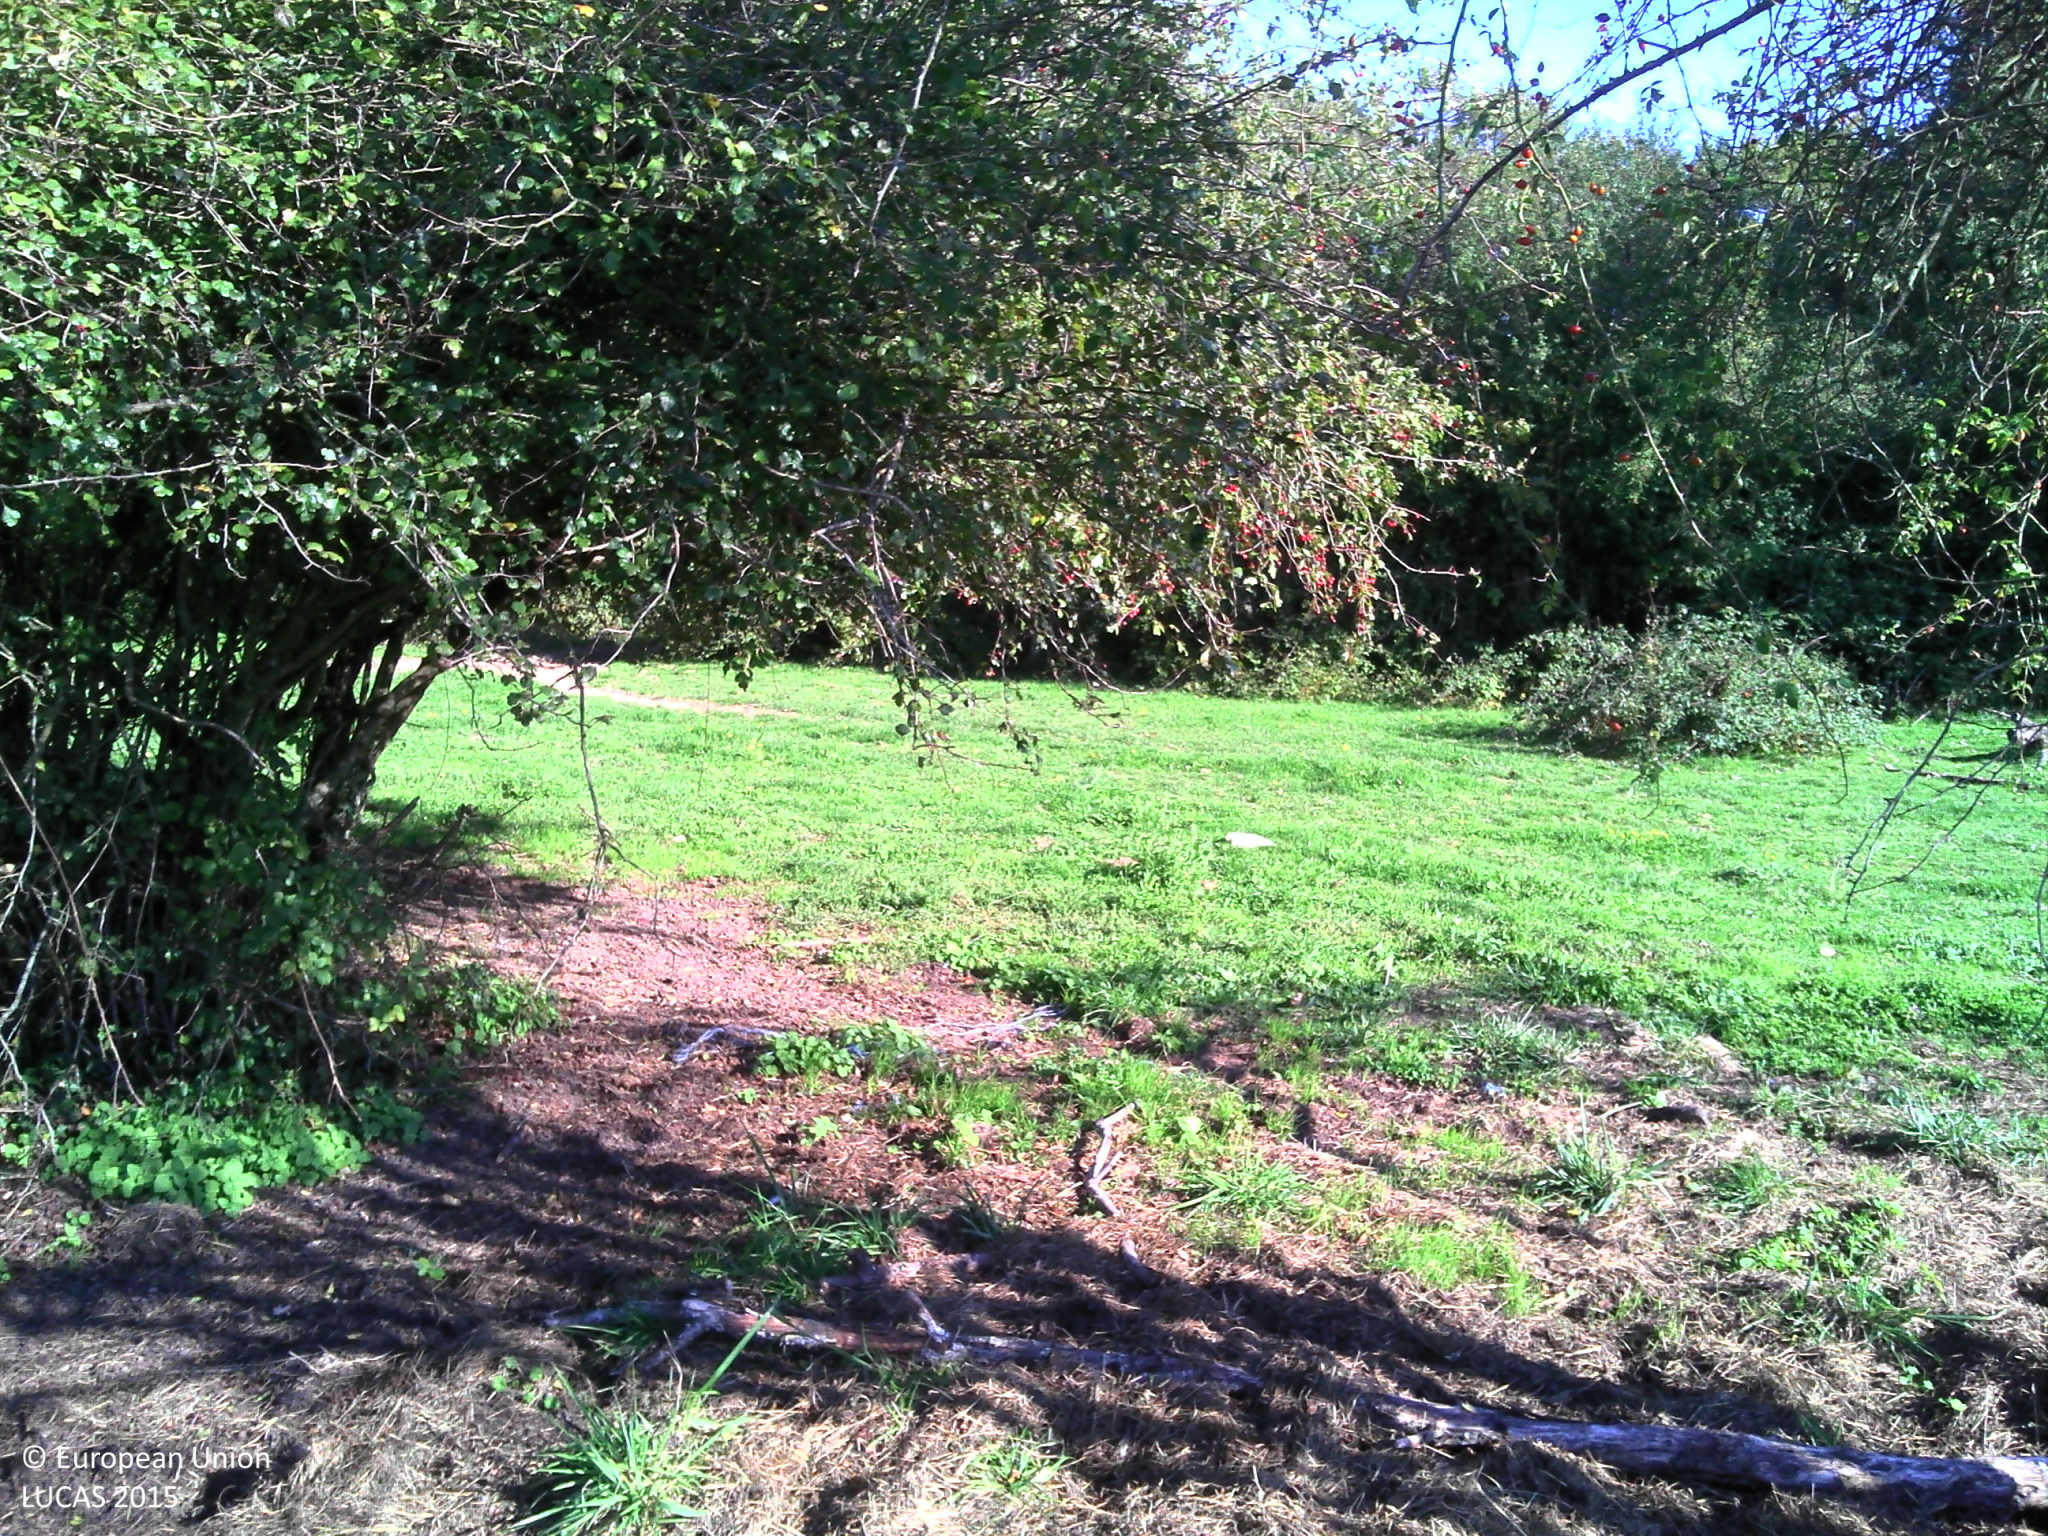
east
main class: Grassland
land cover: Grassland with sparse tree/shrub cover
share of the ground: > 75 %
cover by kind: herbaceous plants 95 %, broadleaved forest trees 5 %
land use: Agriculture (excluding fallow land and kitchen gardens)
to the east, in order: Grassland with sparse tree/shrub cover; Broadleaved woodland; Grassland without tree/shrub cover; Broadleaved woodland; Grassland without tree/shrub cover; Fences; Ditches and canals; Grass margins; Barley; Grass margins; Broadleaved woodland; Tracks; Broadleaved woodland
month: September
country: FR
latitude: 48.0721
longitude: 3.8895
